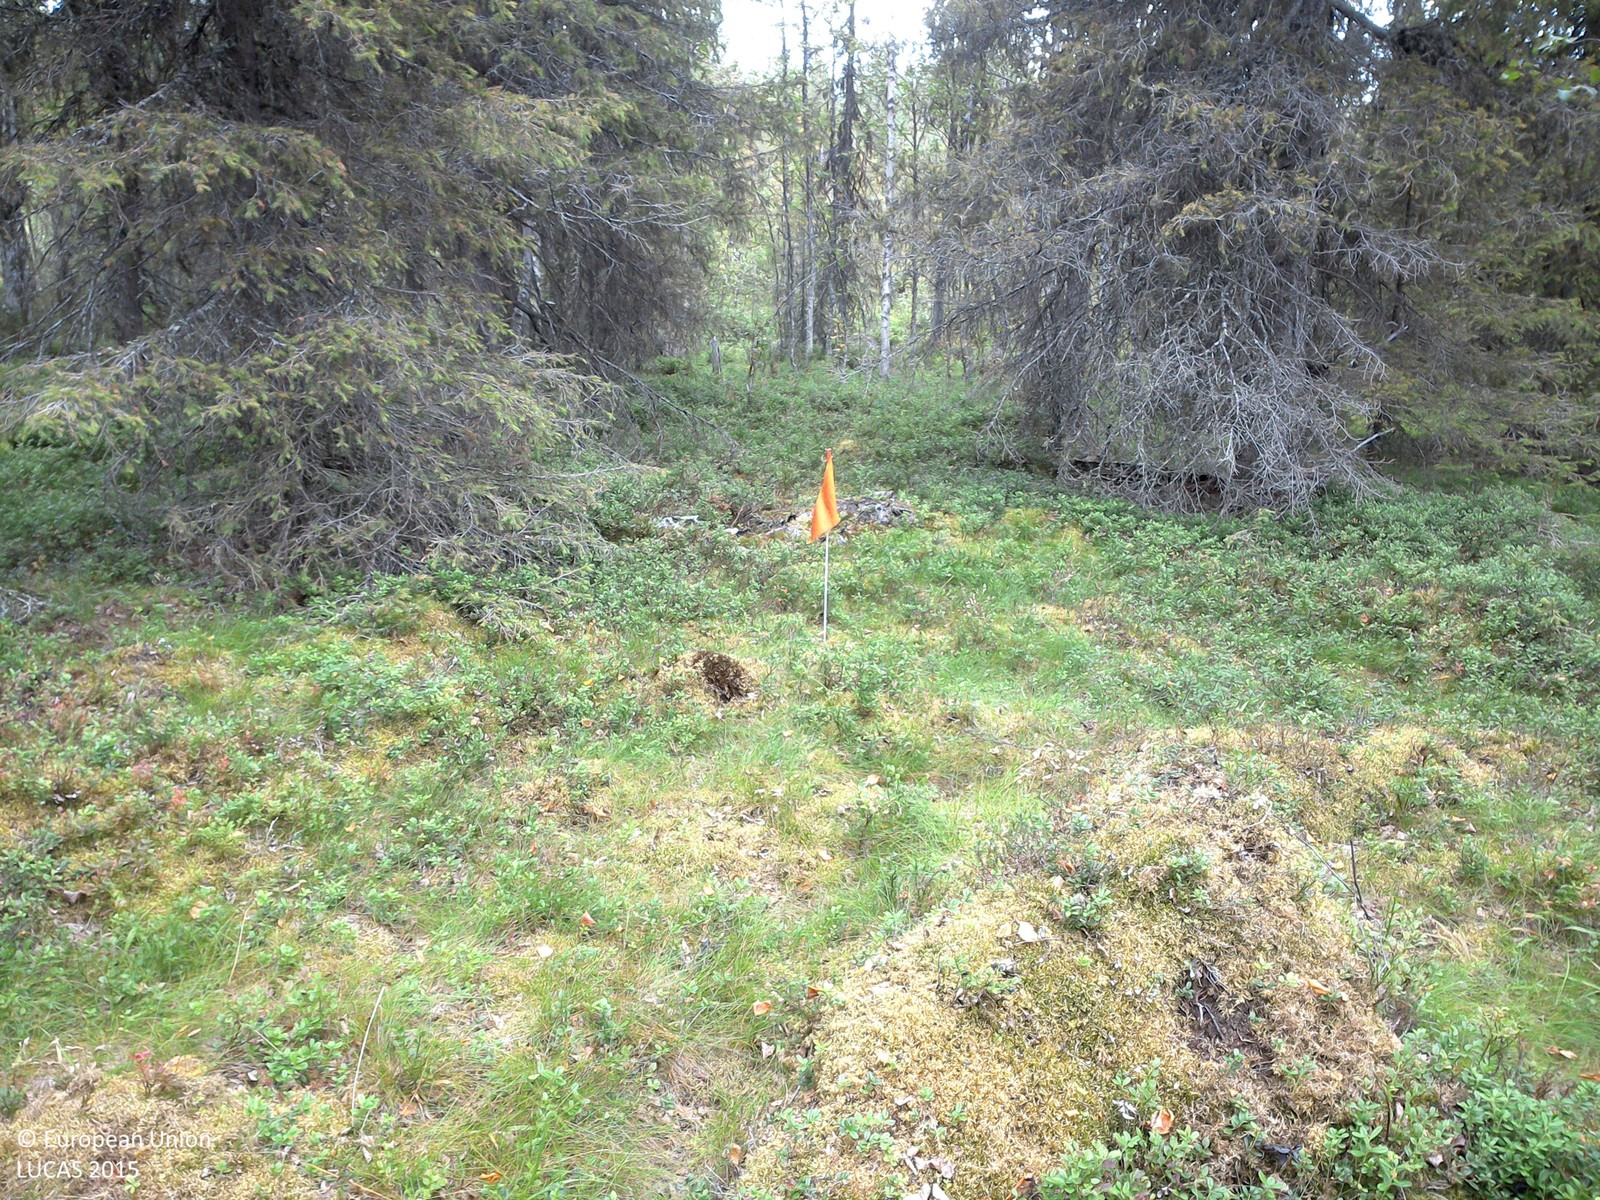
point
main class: Woodland
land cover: Spruce dominated mixed woodland
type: boreal forest
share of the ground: 25 - 50 %
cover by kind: shrubs 50 %, coniferous forest trees 25 %, lichens and mosses 15 %, broadleaved forest trees 10 %
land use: Forestry
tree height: > 5 m
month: August
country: SE
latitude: 67.2824
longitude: 21.9524
